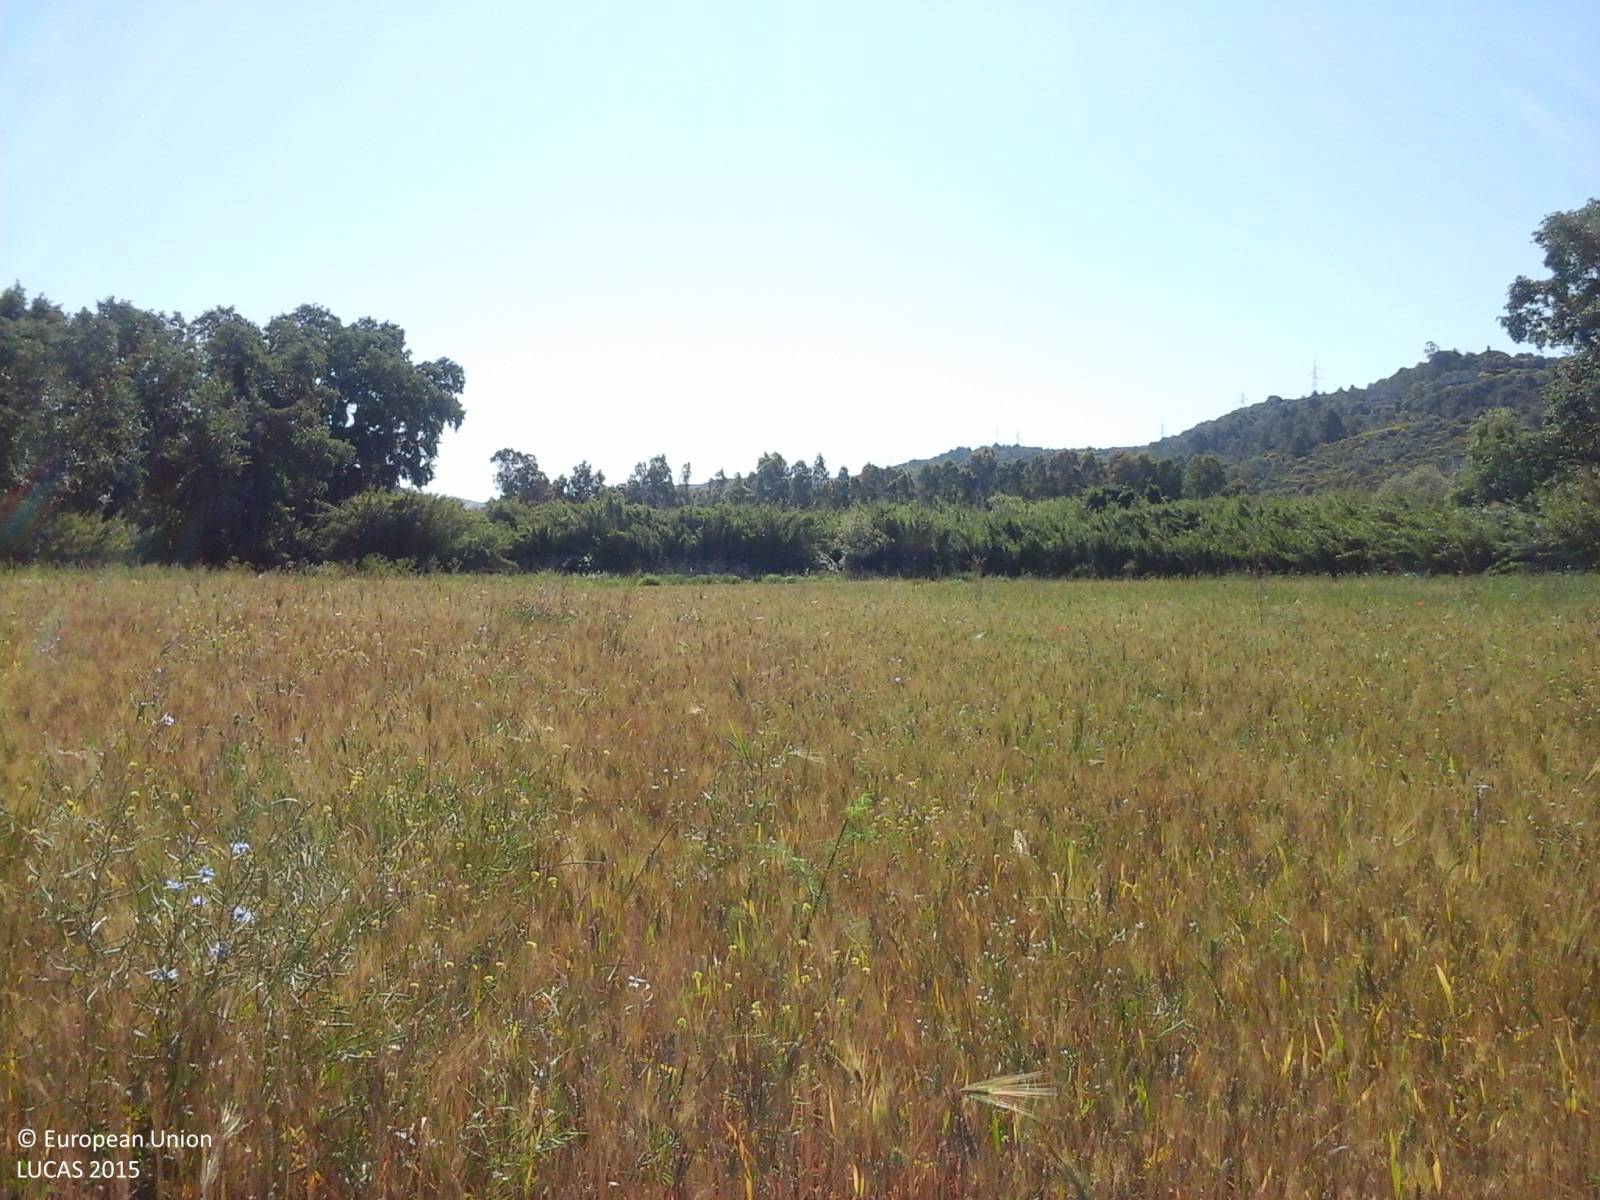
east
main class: Cropland
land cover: Durum wheat
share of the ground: > 75 %
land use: Agriculture (excluding fallow land and kitchen gardens)
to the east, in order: Durum wheat; Paved roads, cycling and walking lanes; Durum wheat; Shrubland without tree cover; Durum wheat
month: May
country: IT
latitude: 40.6907
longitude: 8.5280
